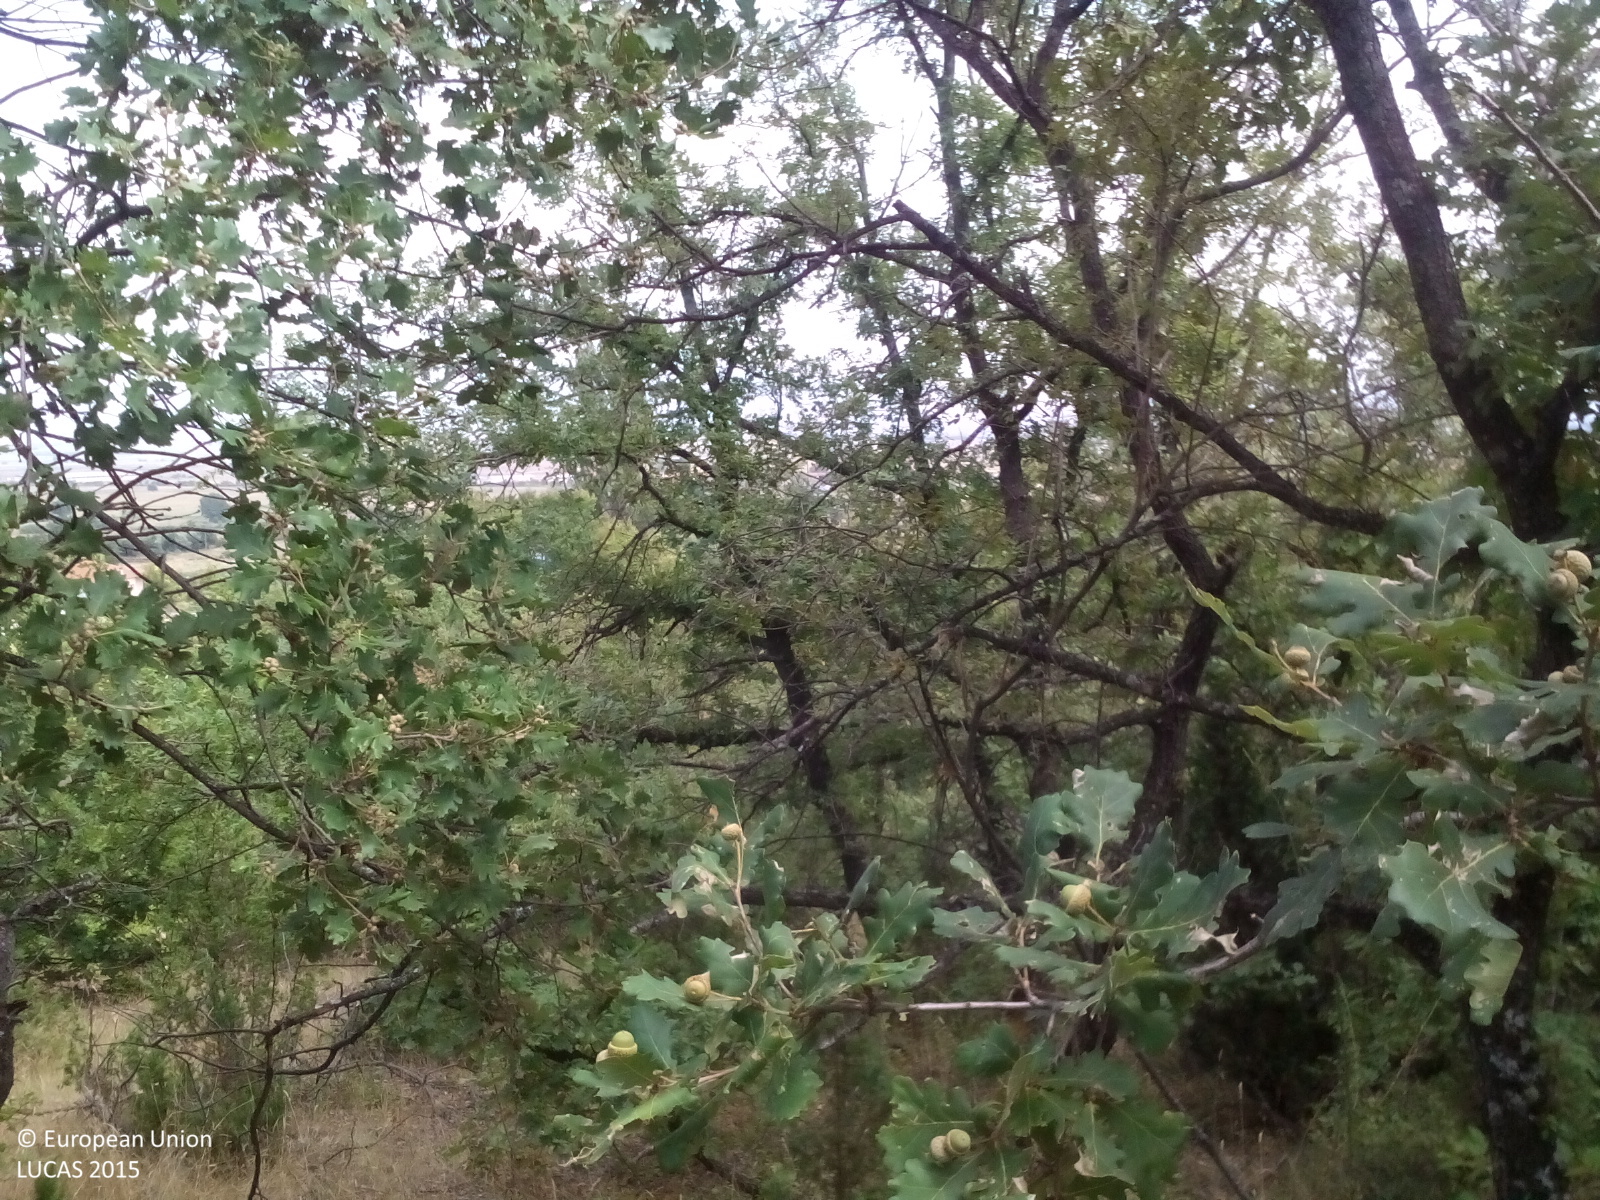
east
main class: Woodland
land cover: Broadleaved woodland
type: thermophilous deciduous forest
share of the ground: 50 - 75 %
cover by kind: broadleaved forest trees 60 %, herbaceous plants 30 %, shrubs 10 %
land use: Semi-natural and natural areas not in use
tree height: > 5 m
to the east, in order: Broadleaved woodland; Shrubland without tree cover; Spontaneously vegetated surfaces; Paved roads, cycling and walking lanes; Shrubland without tree cover; Spontaneously vegetated surfaces
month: August
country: GR
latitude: 40.8039
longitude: 21.4088
